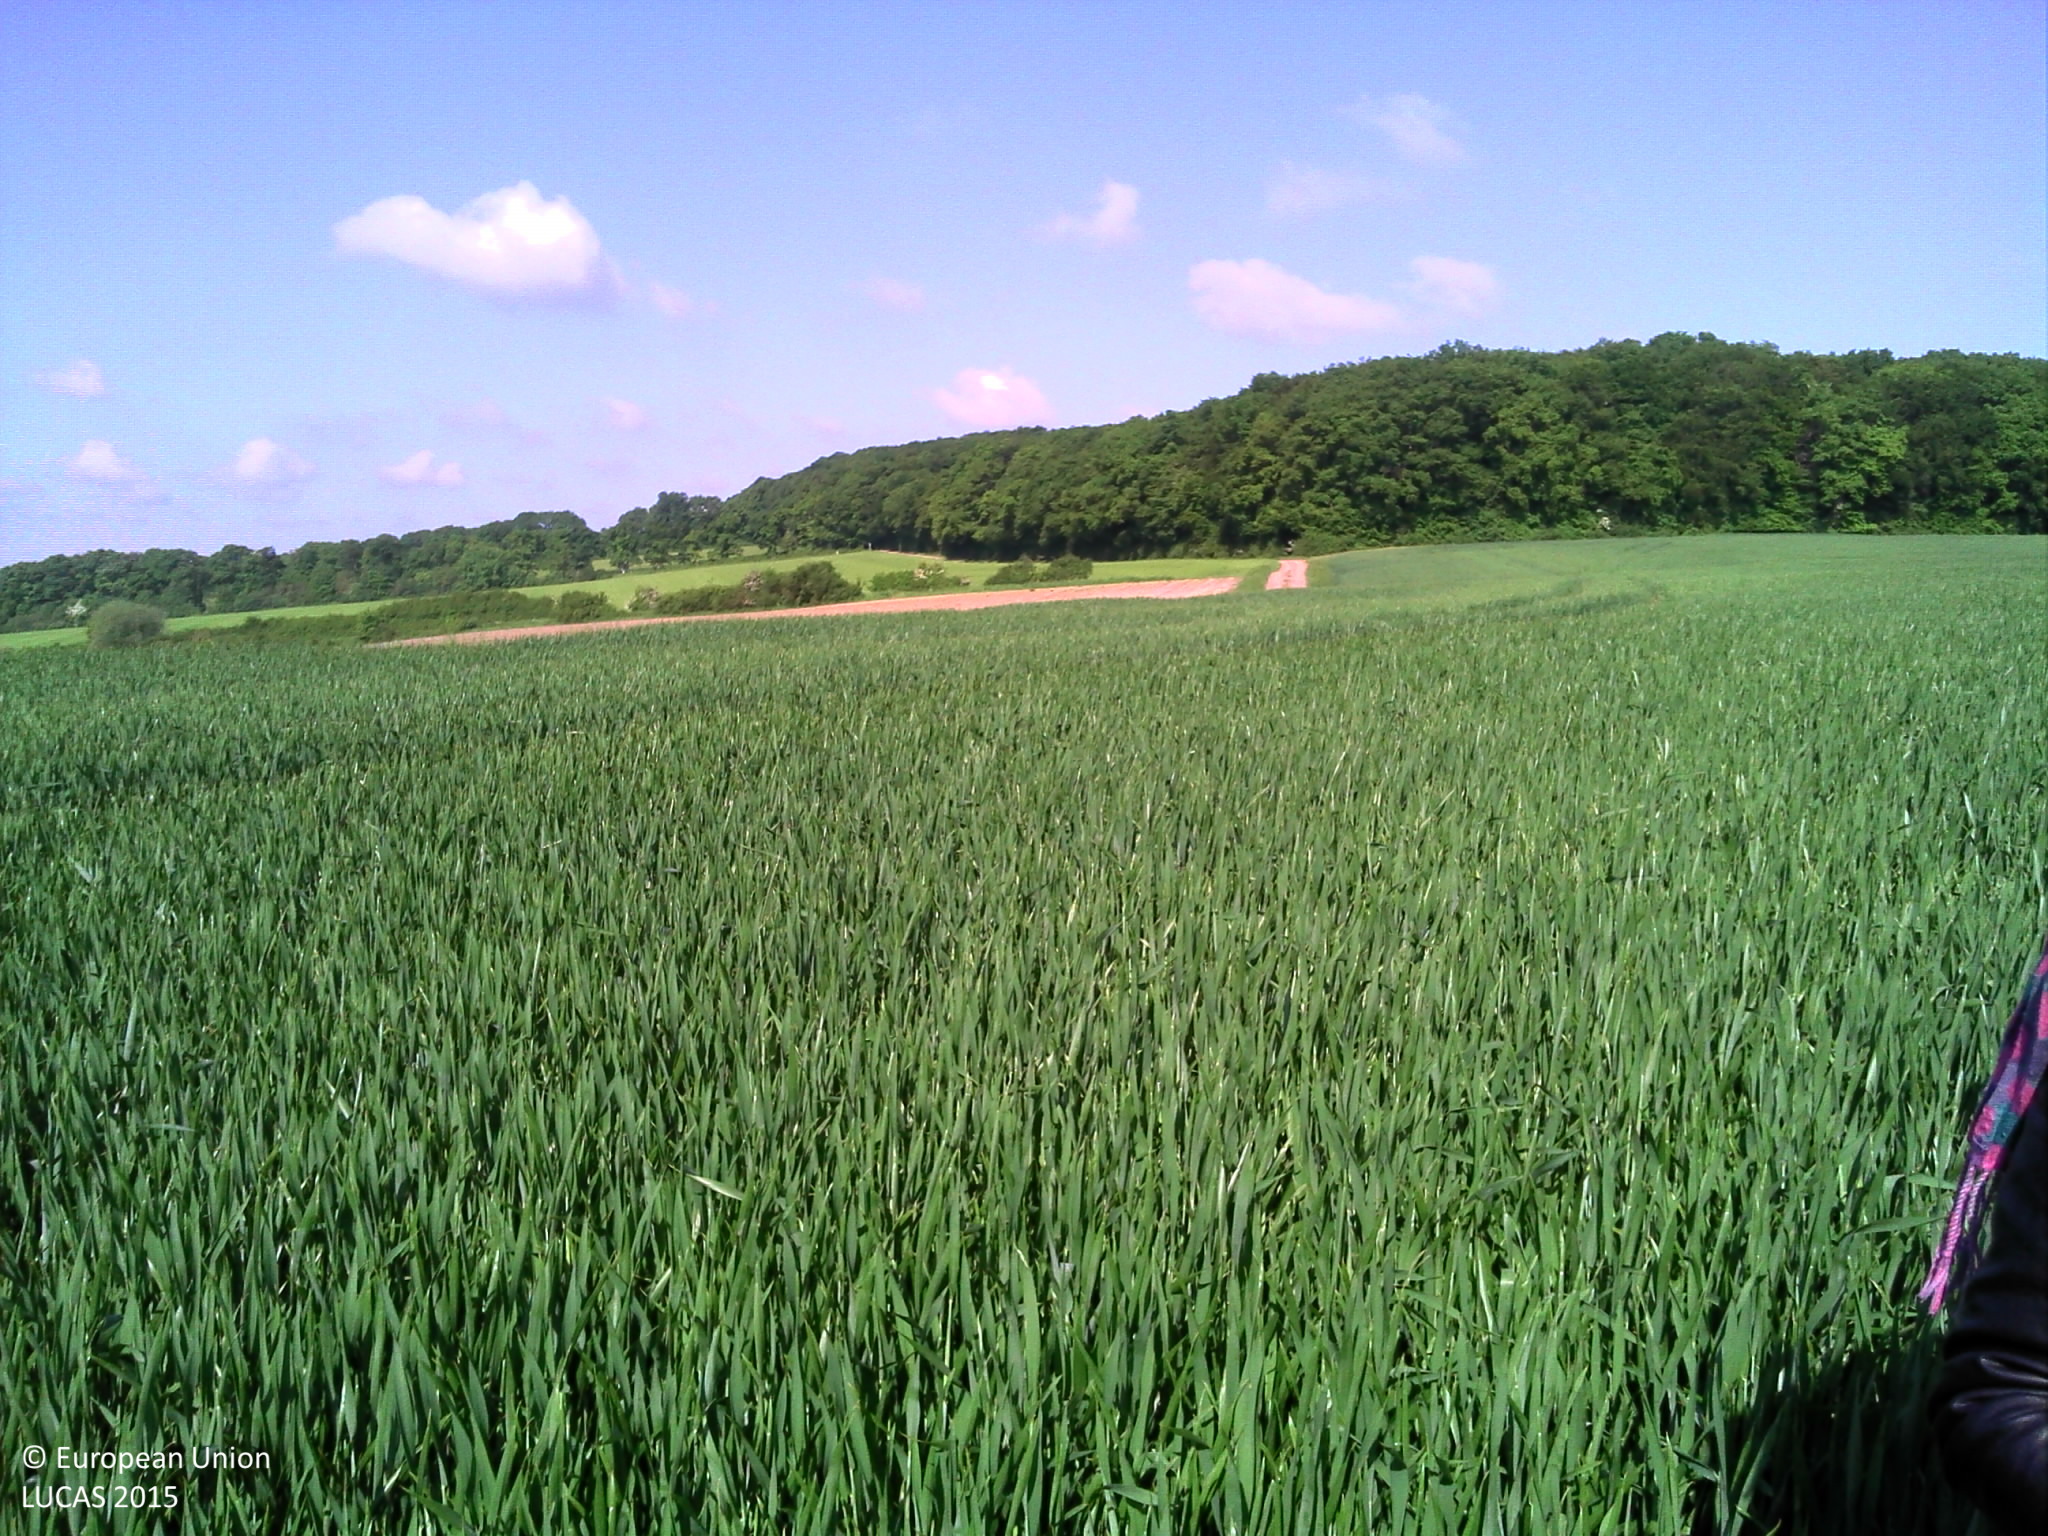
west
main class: Cropland
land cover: Common wheat
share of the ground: > 75 %
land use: Agriculture (excluding fallow land and kitchen gardens)
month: May
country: LU
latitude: 49.7137
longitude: 6.4077
